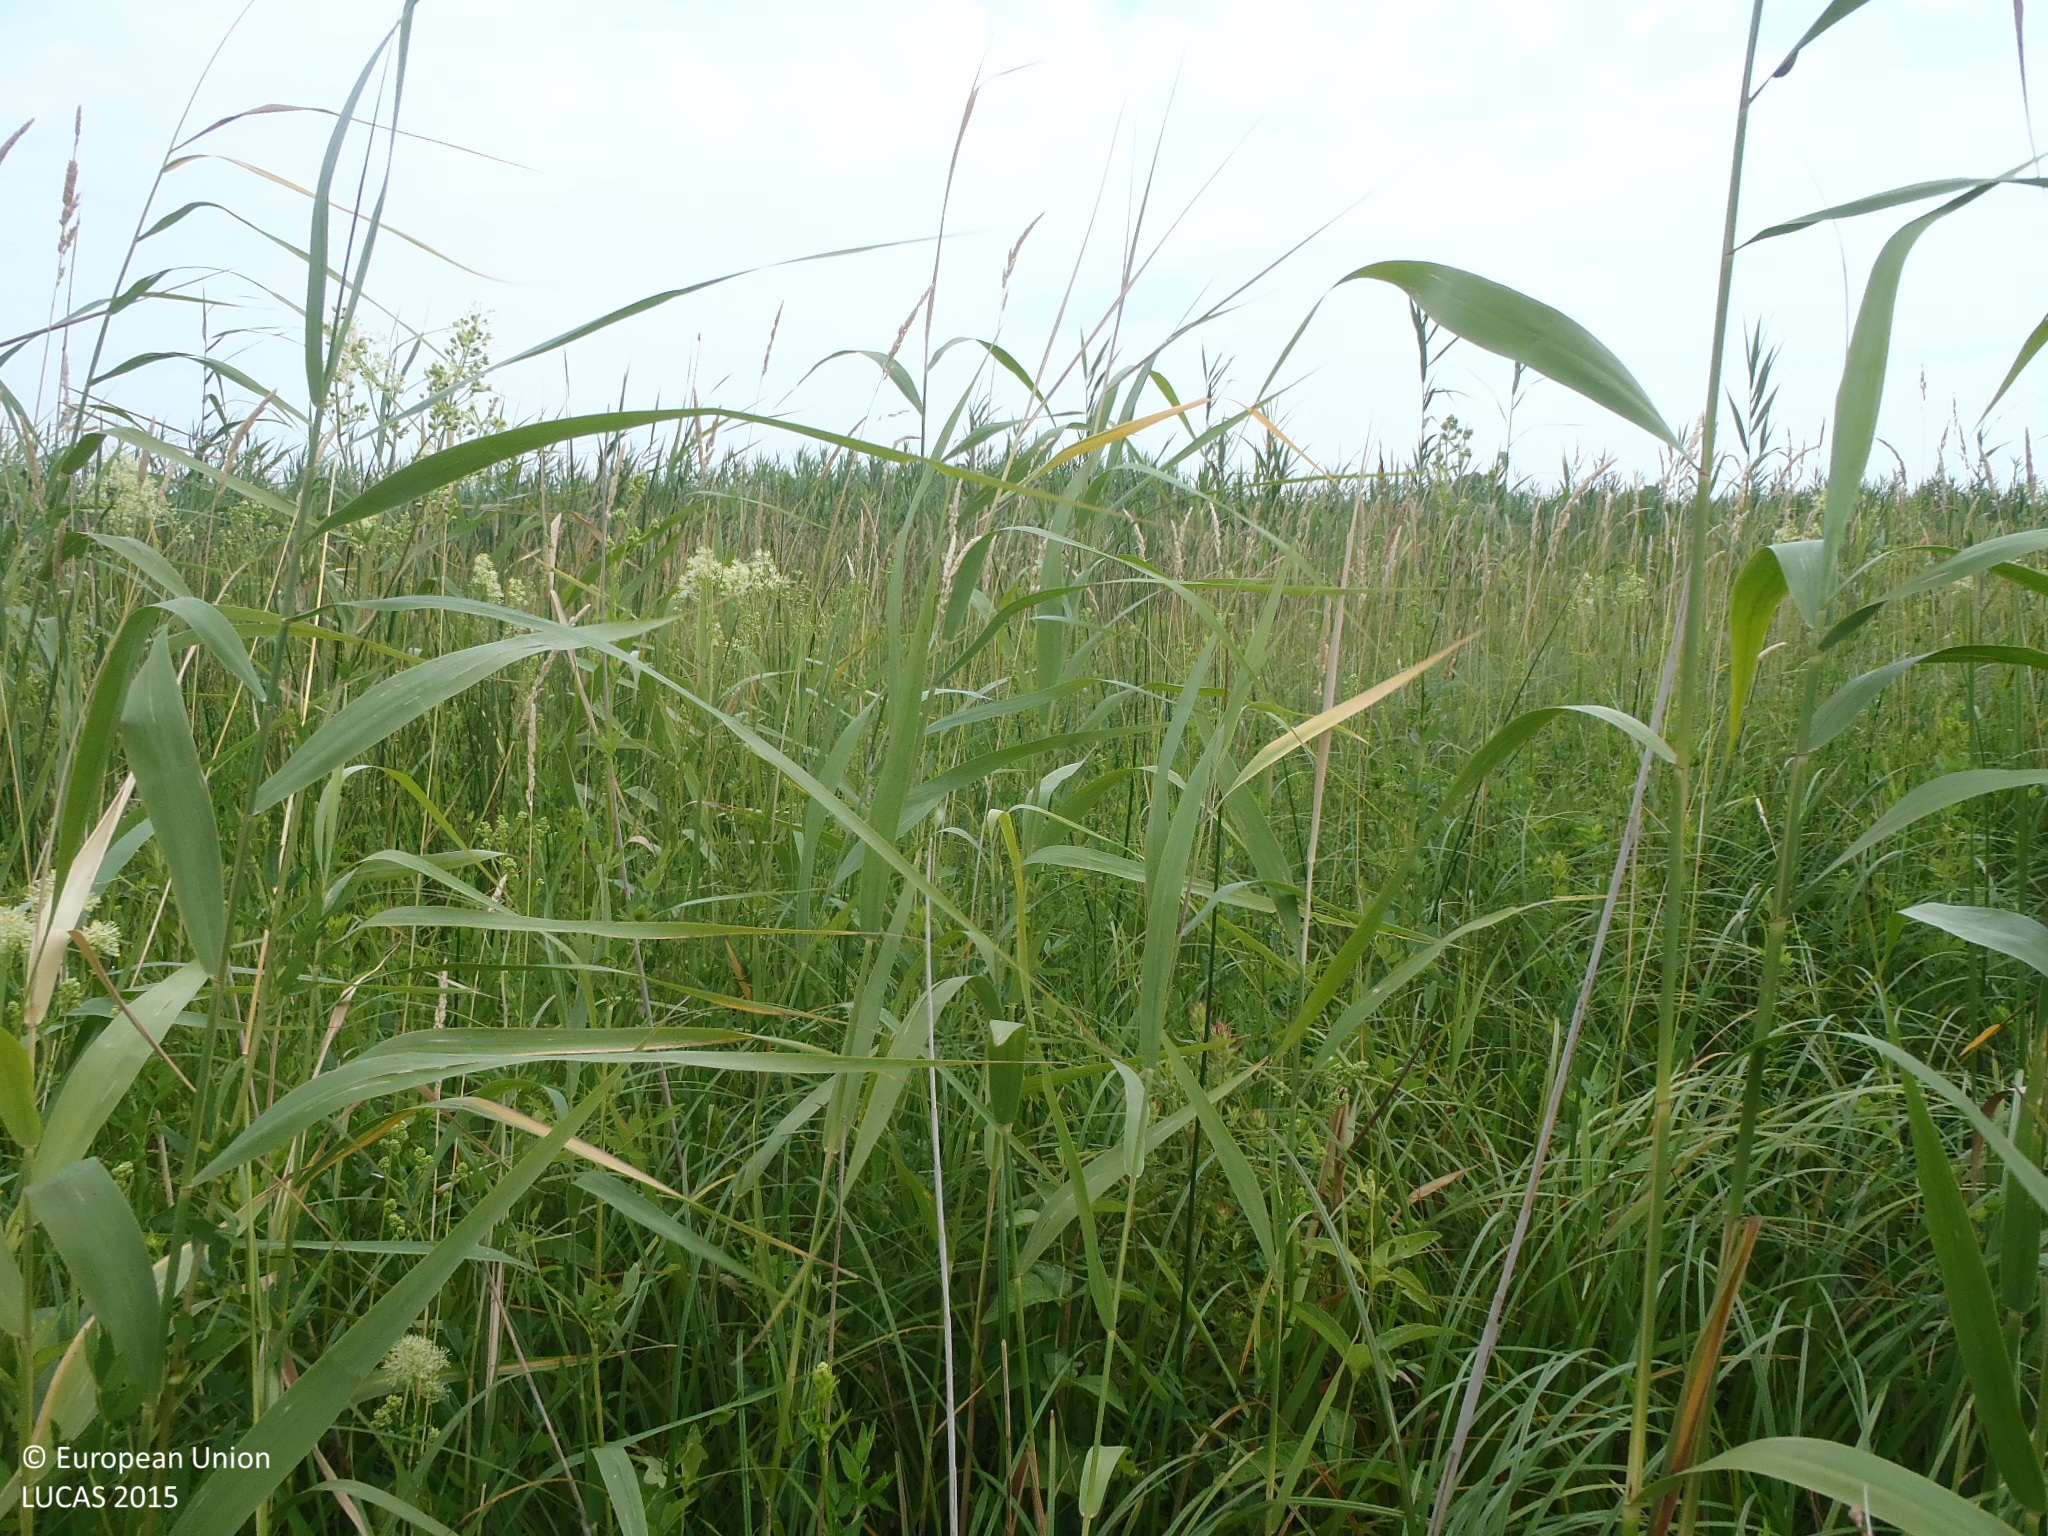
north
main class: Grassland
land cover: Spontaneously vegetated surfaces
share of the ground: > 75 %
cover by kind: herbaceous plants 95 %, shrubs 5 %
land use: Semi-natural and natural areas not in use
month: July
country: BG
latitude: 44.0016
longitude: 26.3312
